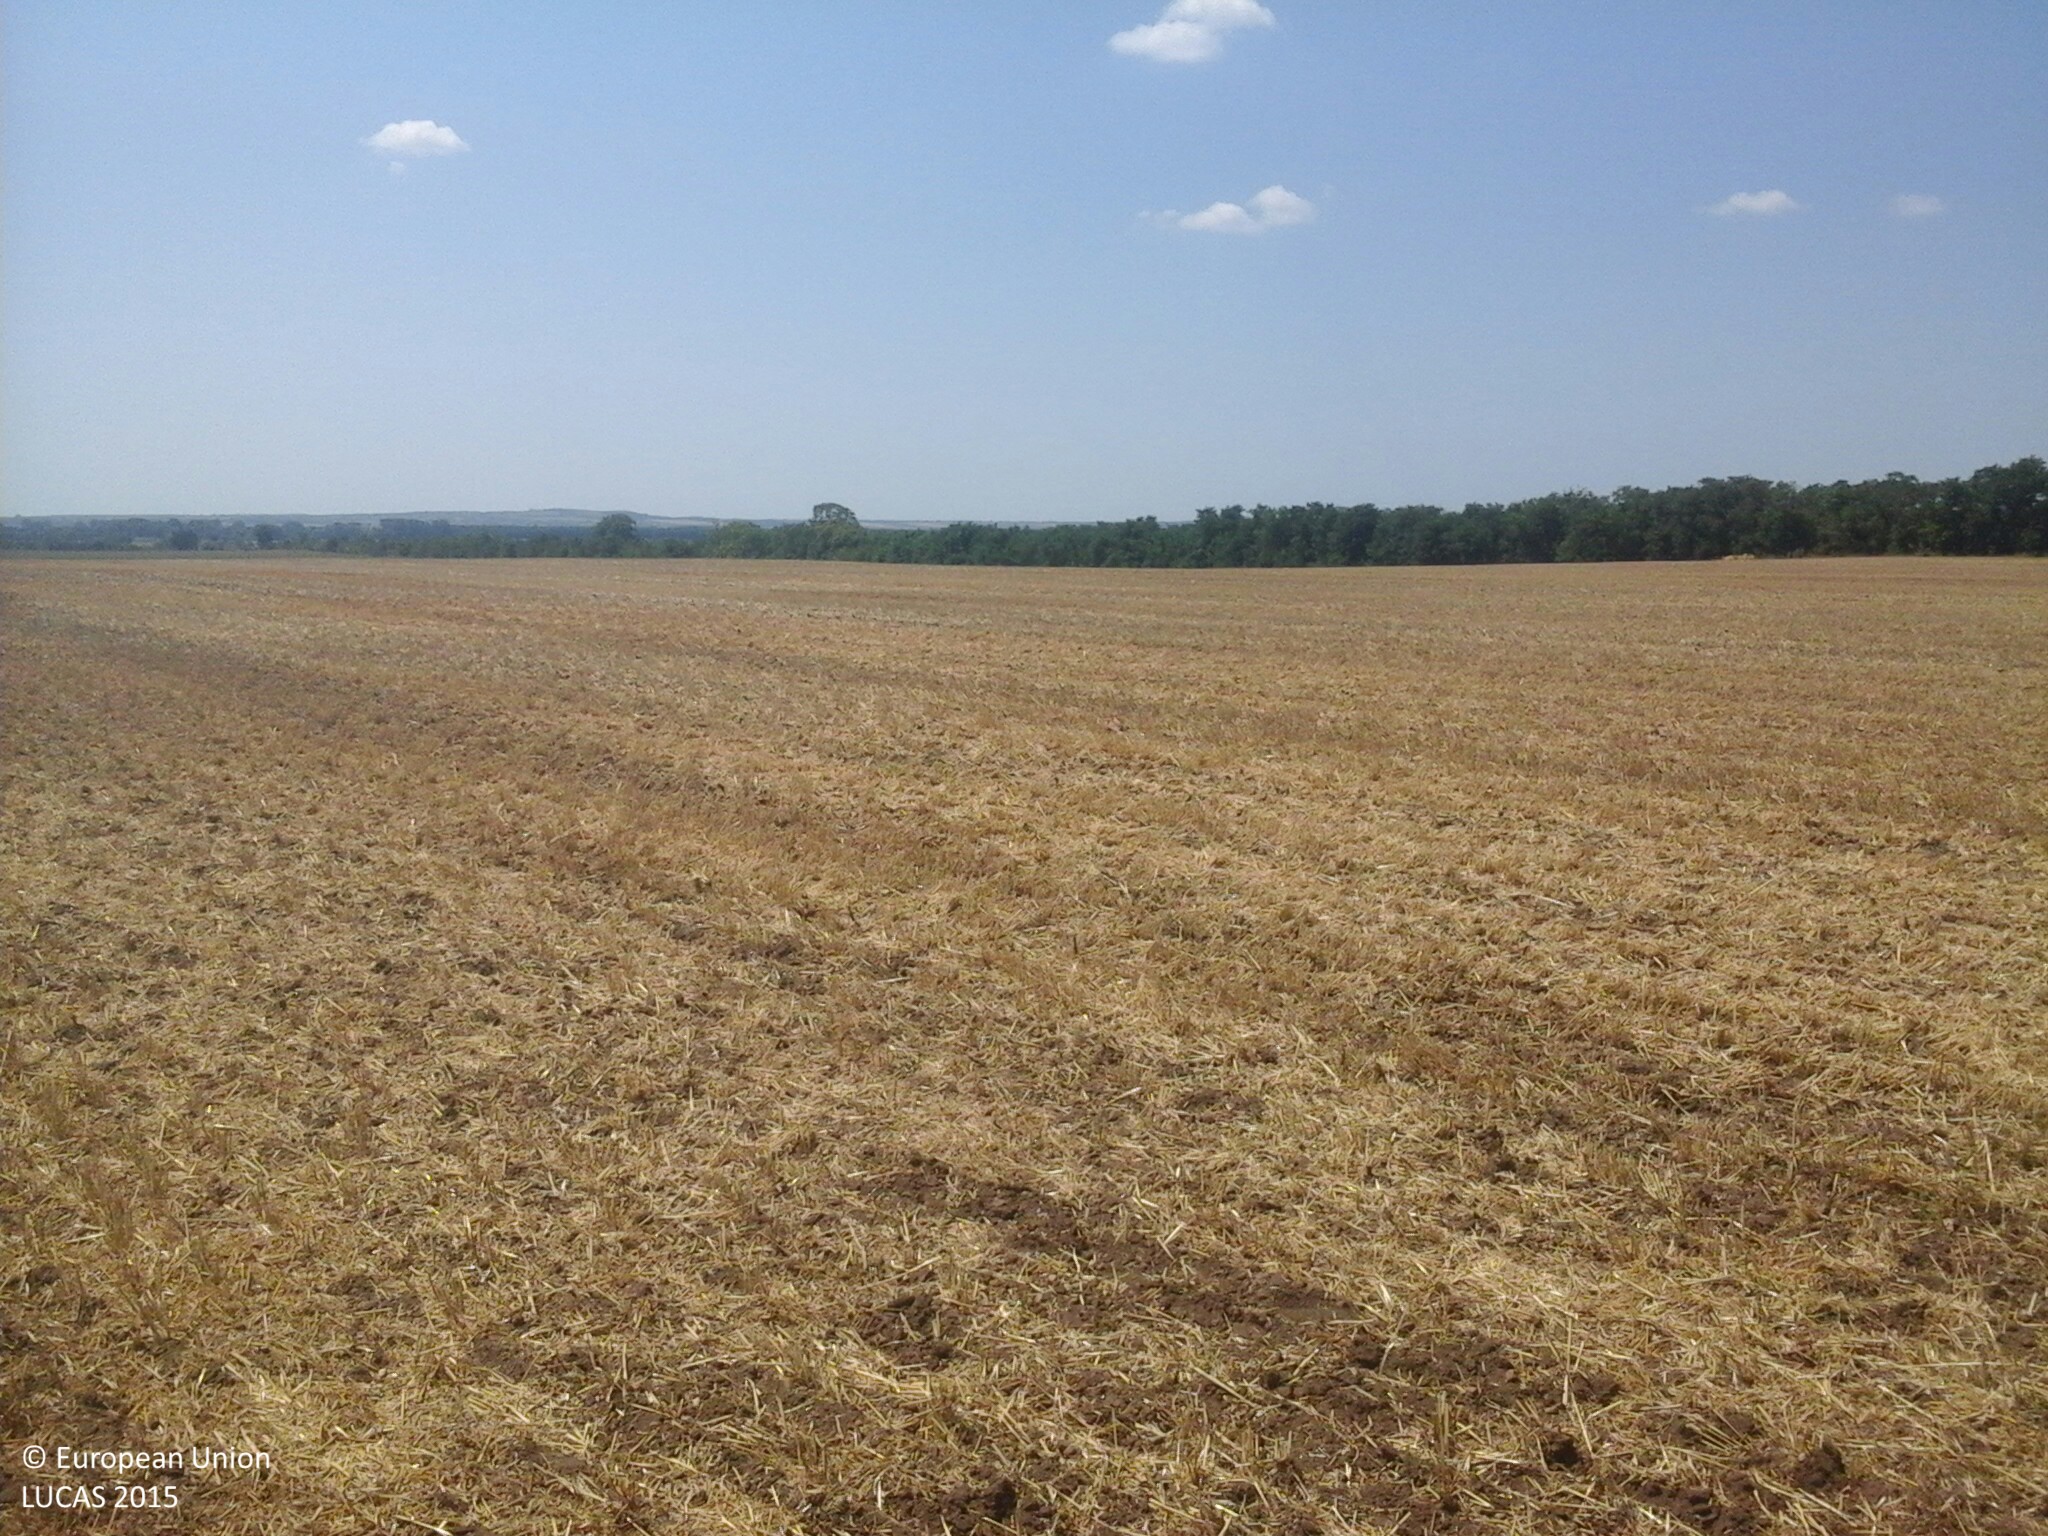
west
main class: Cropland
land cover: Common wheat
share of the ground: < 10 %
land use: Agriculture (excluding fallow land and kitchen gardens)
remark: Harvested field
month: July
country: HU
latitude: 47.1198
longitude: 18.4610
